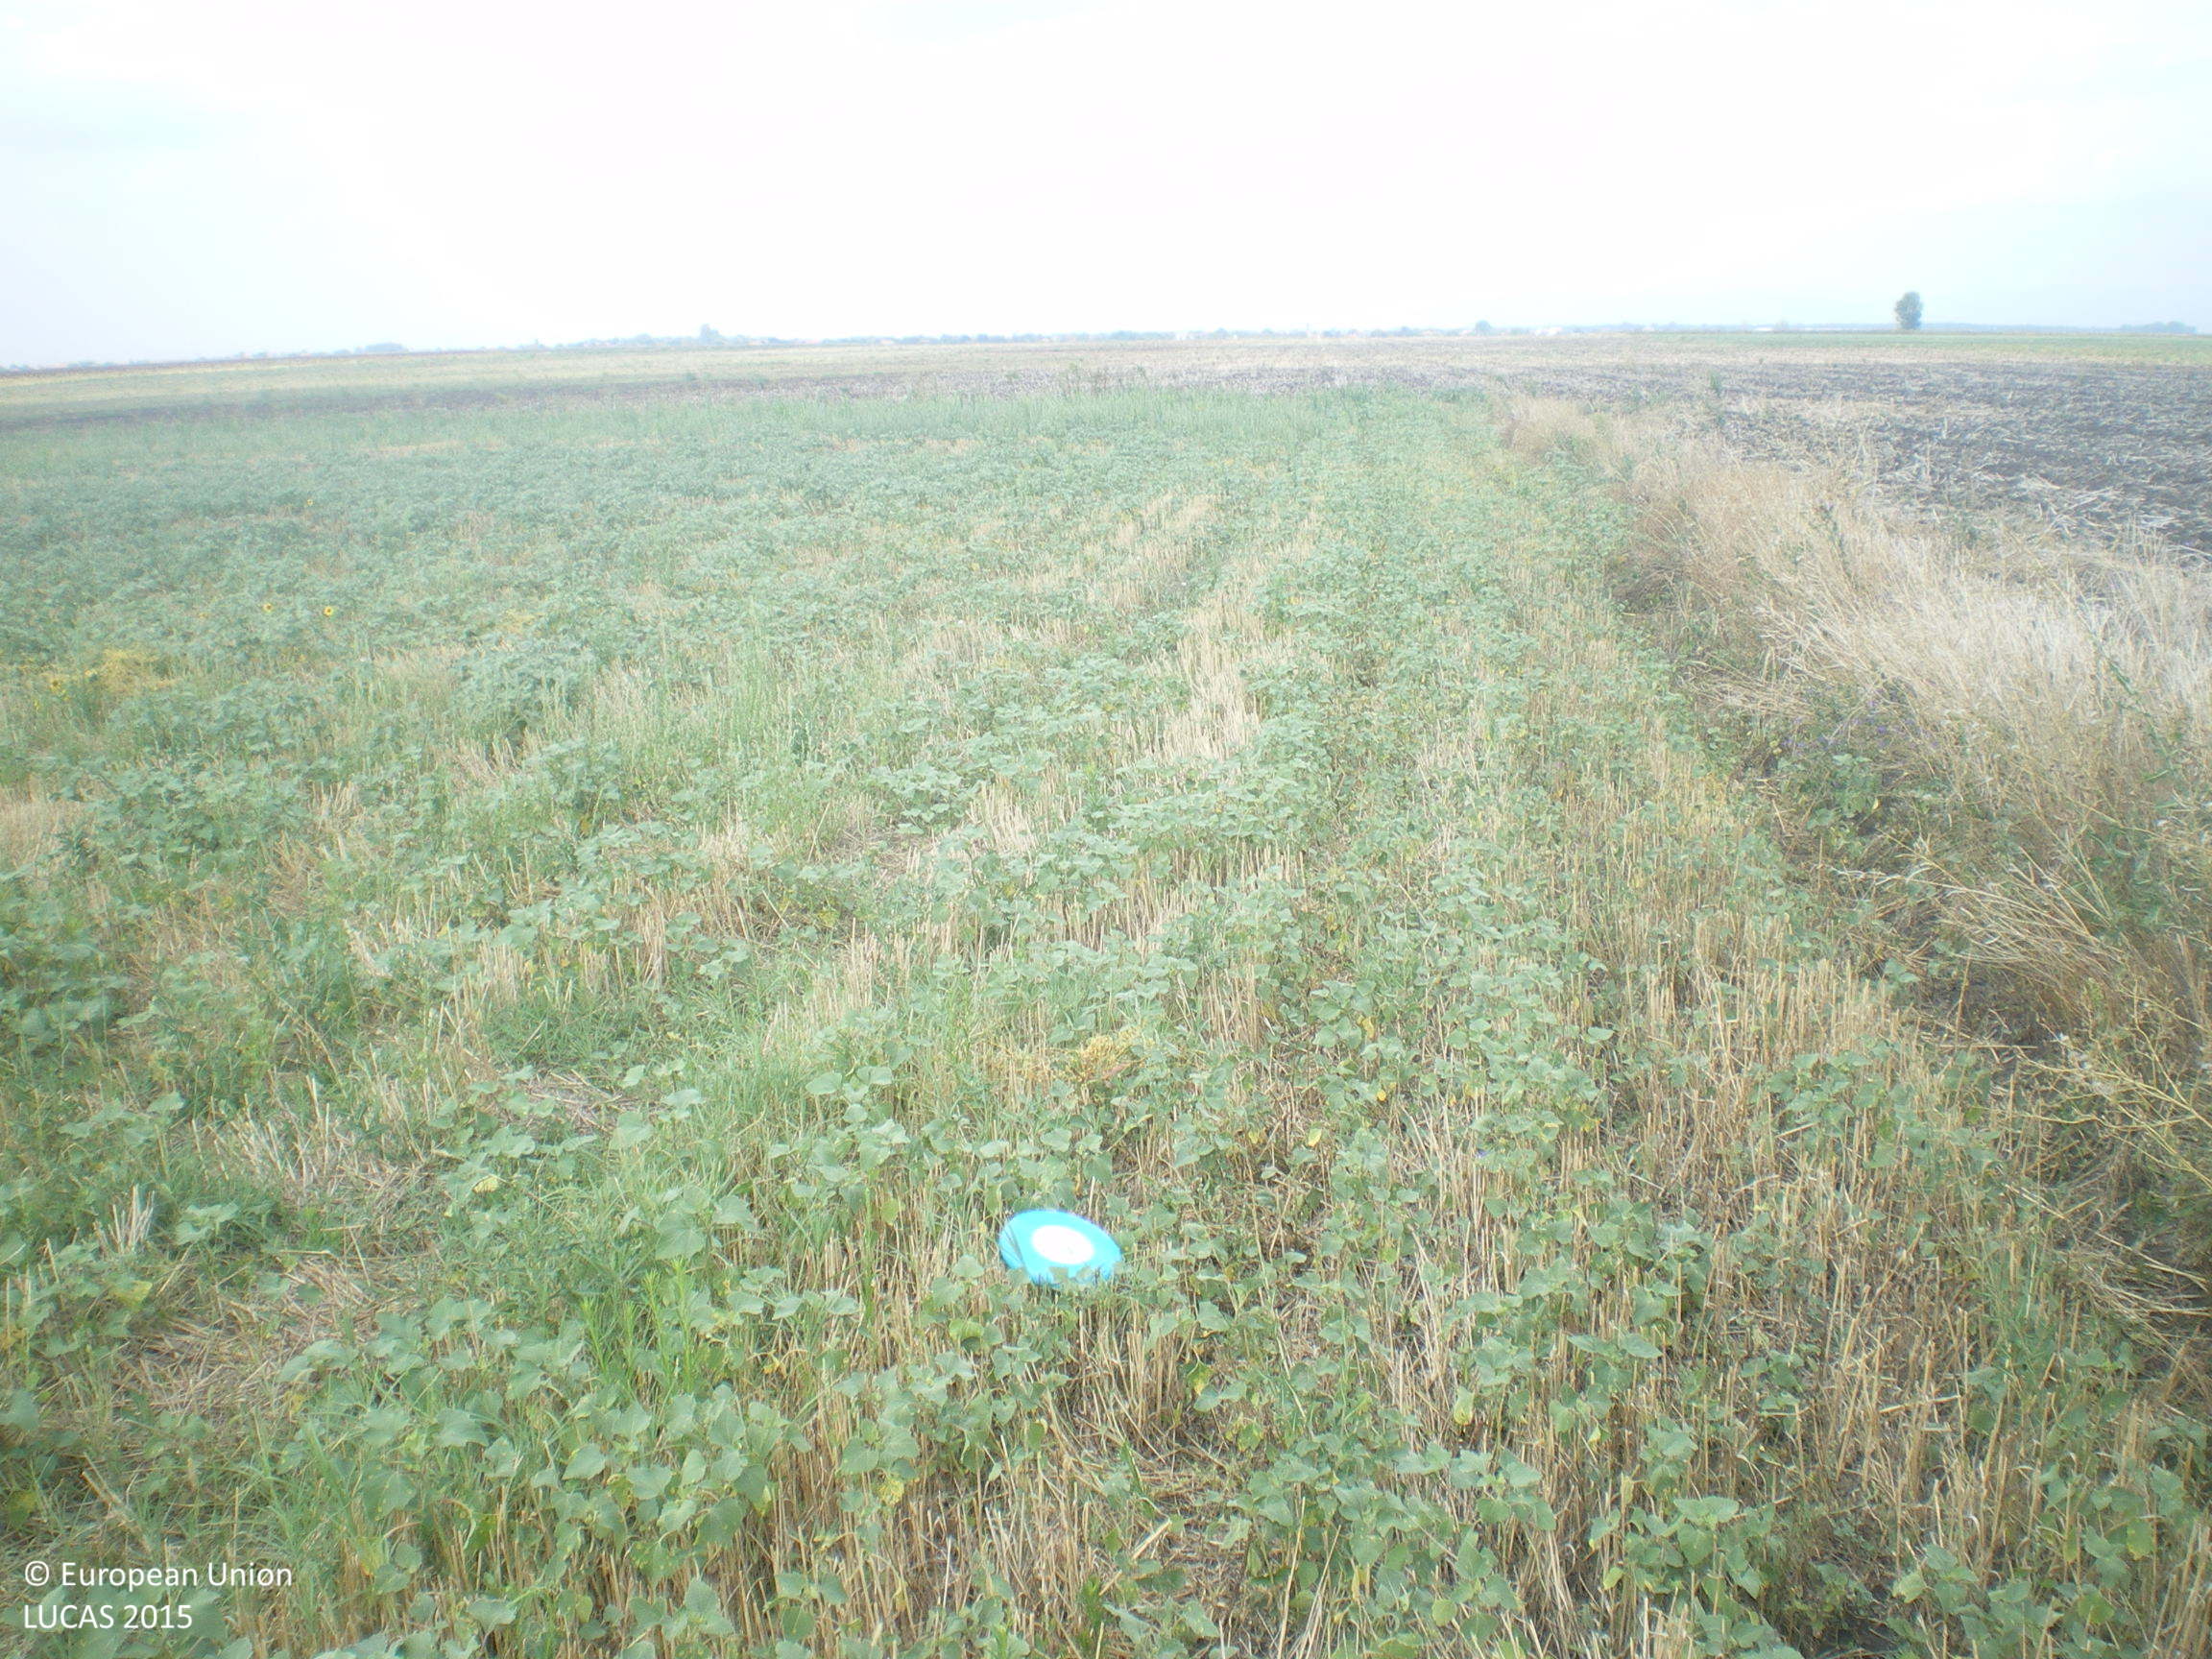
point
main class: Cropland
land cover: Common wheat
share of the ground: < 10 %
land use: Agriculture (excluding fallow land and kitchen gardens)
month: August
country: BG
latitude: 42.3488
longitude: 25.8693
